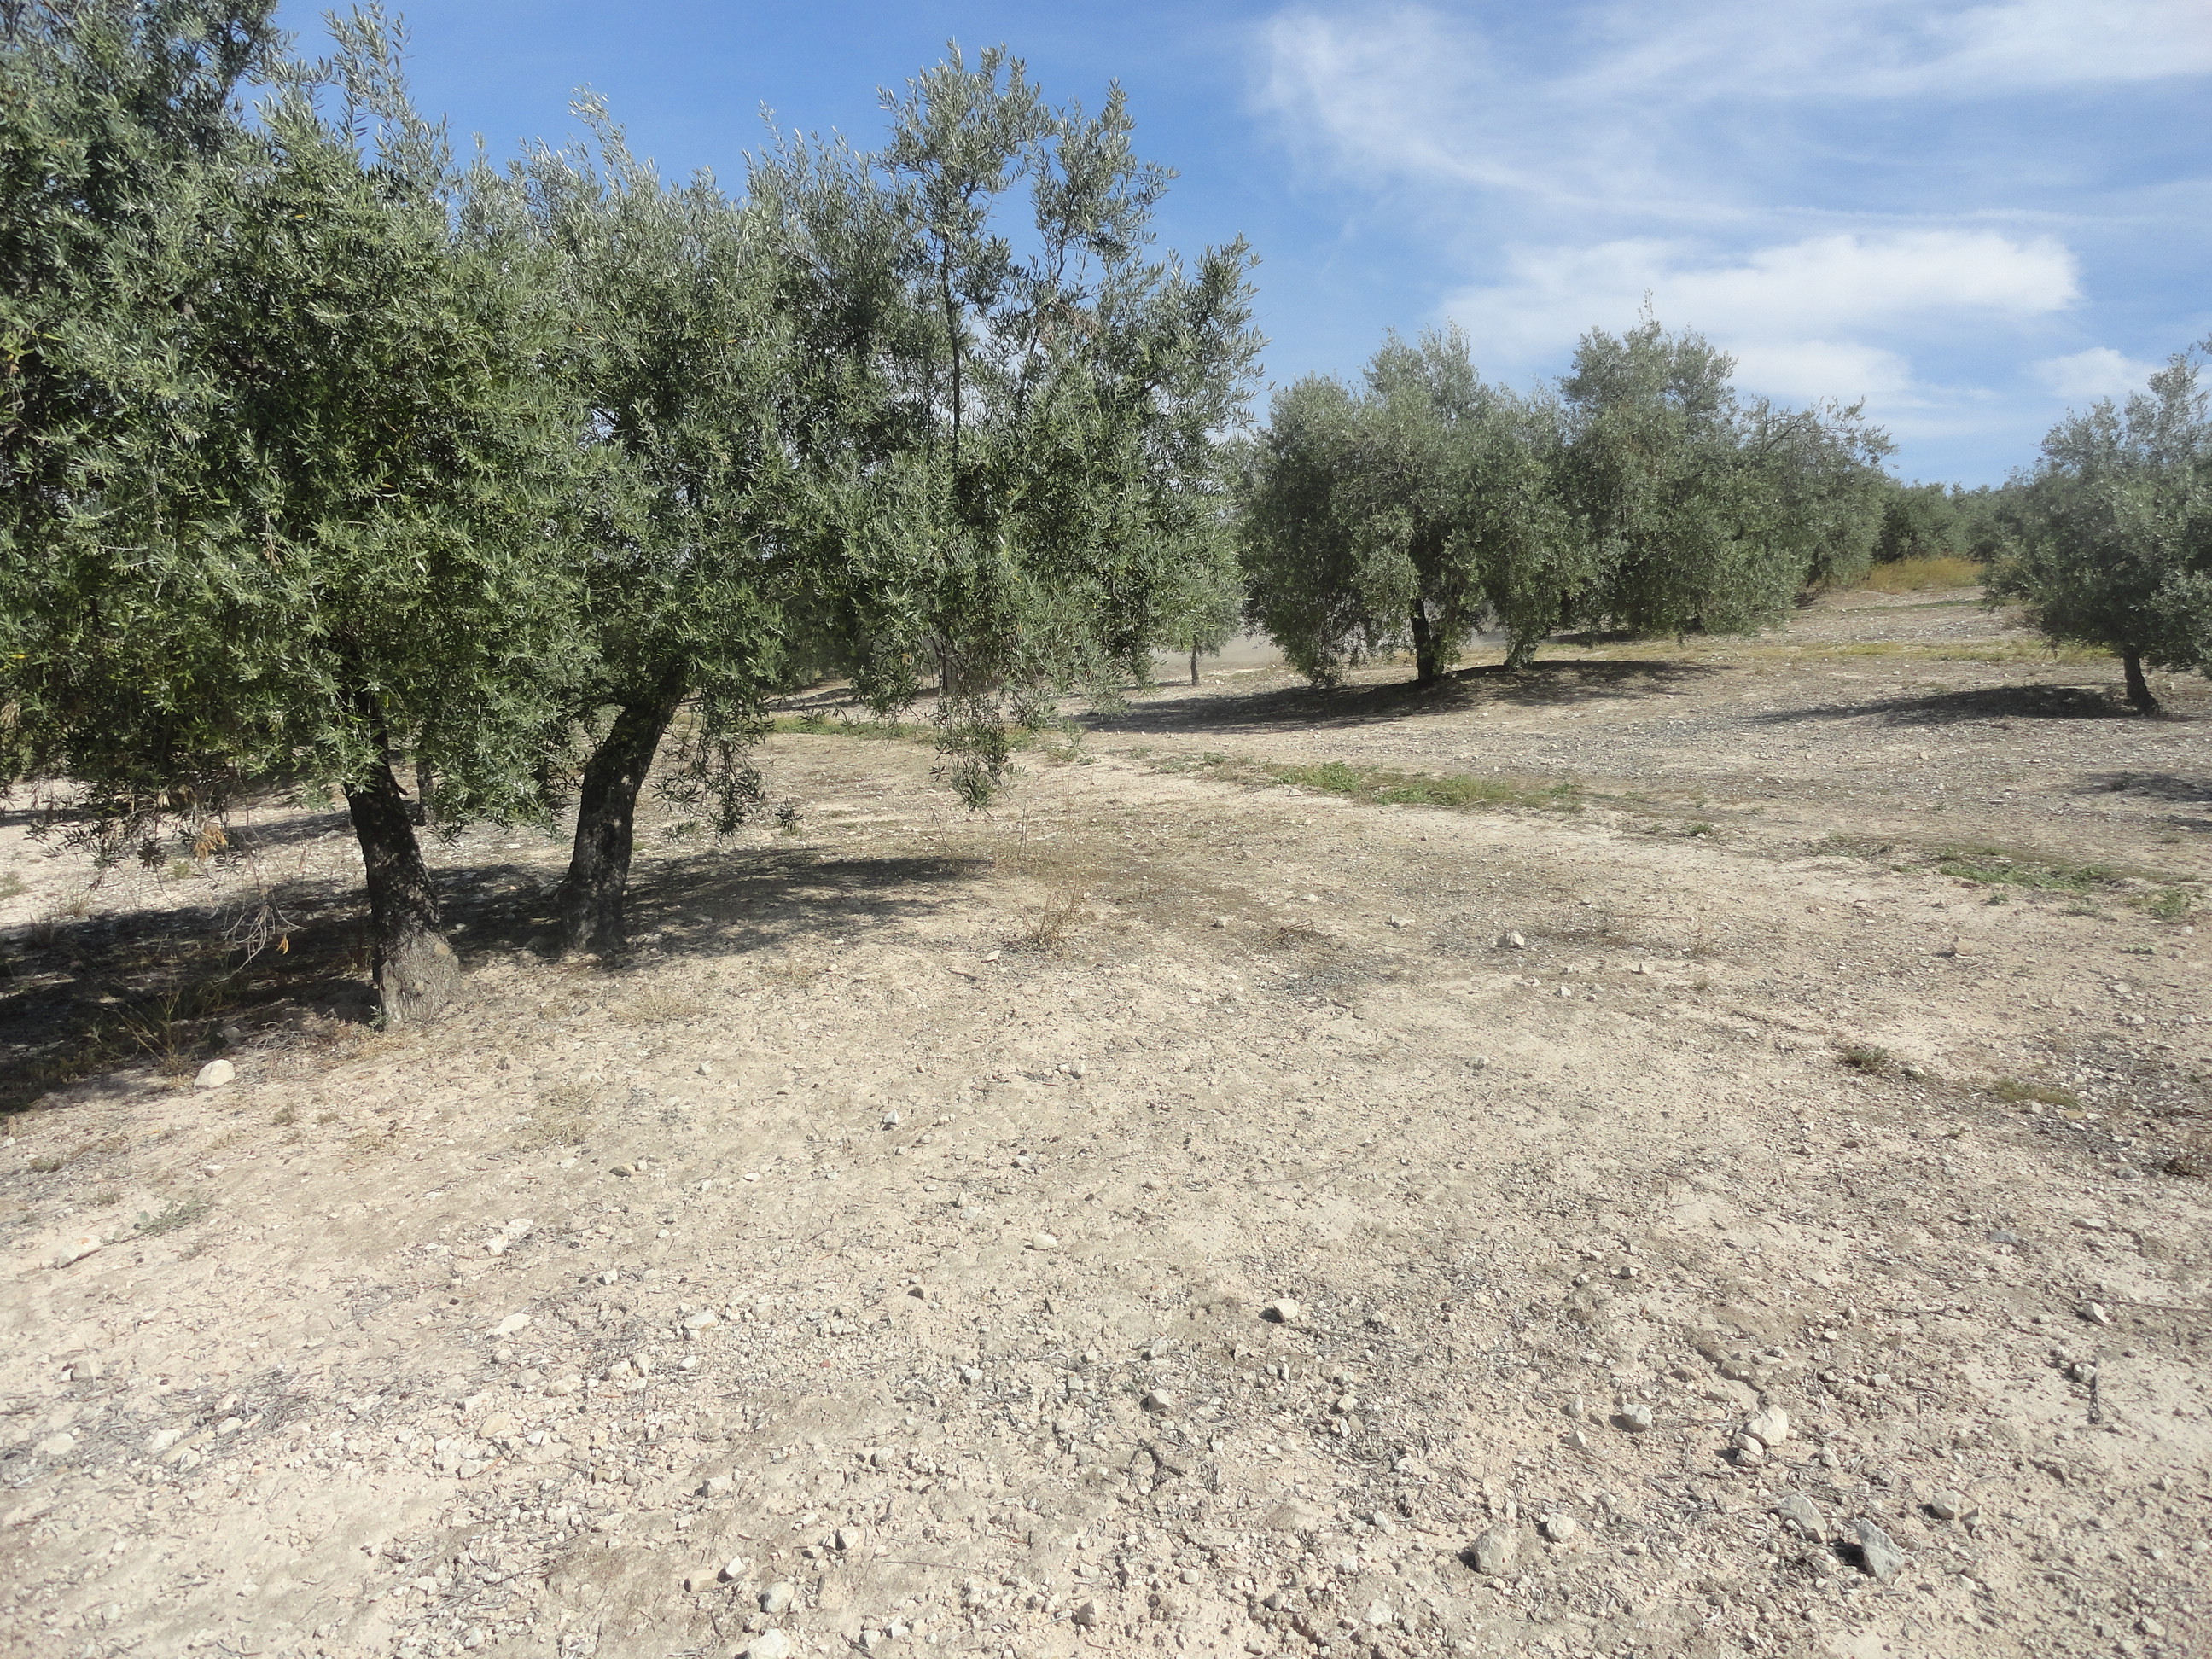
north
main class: Cropland
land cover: Olive groves
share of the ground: 25 - 50 %
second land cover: Spontaneously vegetated surfaces
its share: 10 - 25 %
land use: Agriculture (excluding fallow land and kitchen gardens)
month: April
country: ES
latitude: 37.6053
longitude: -4.4938
